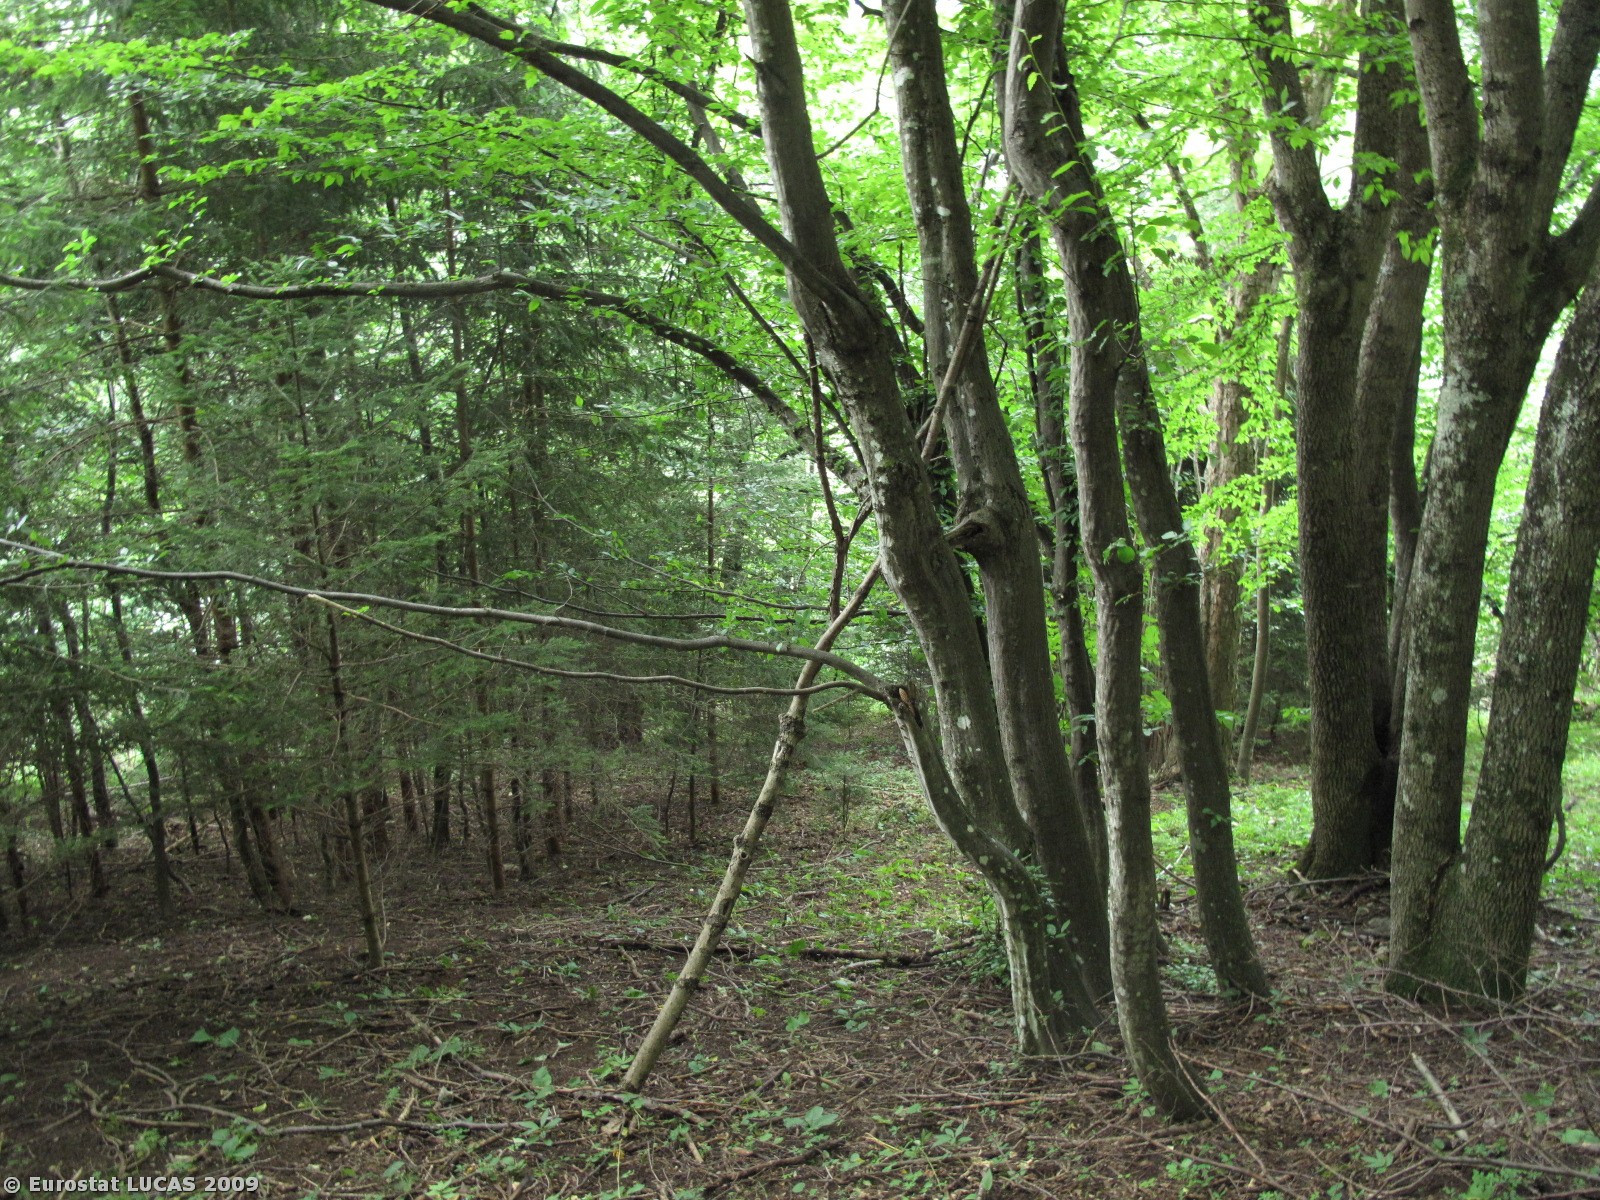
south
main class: Woodland
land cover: Mixed woodland
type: hemiboreal forest and nemoral coniferous forest and mixed broadleaved-coniferous forest
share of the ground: > 75 %
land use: Forestry
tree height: > 5 m
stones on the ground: < 10 %
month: July
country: AT
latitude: 47.9471
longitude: 15.3973
